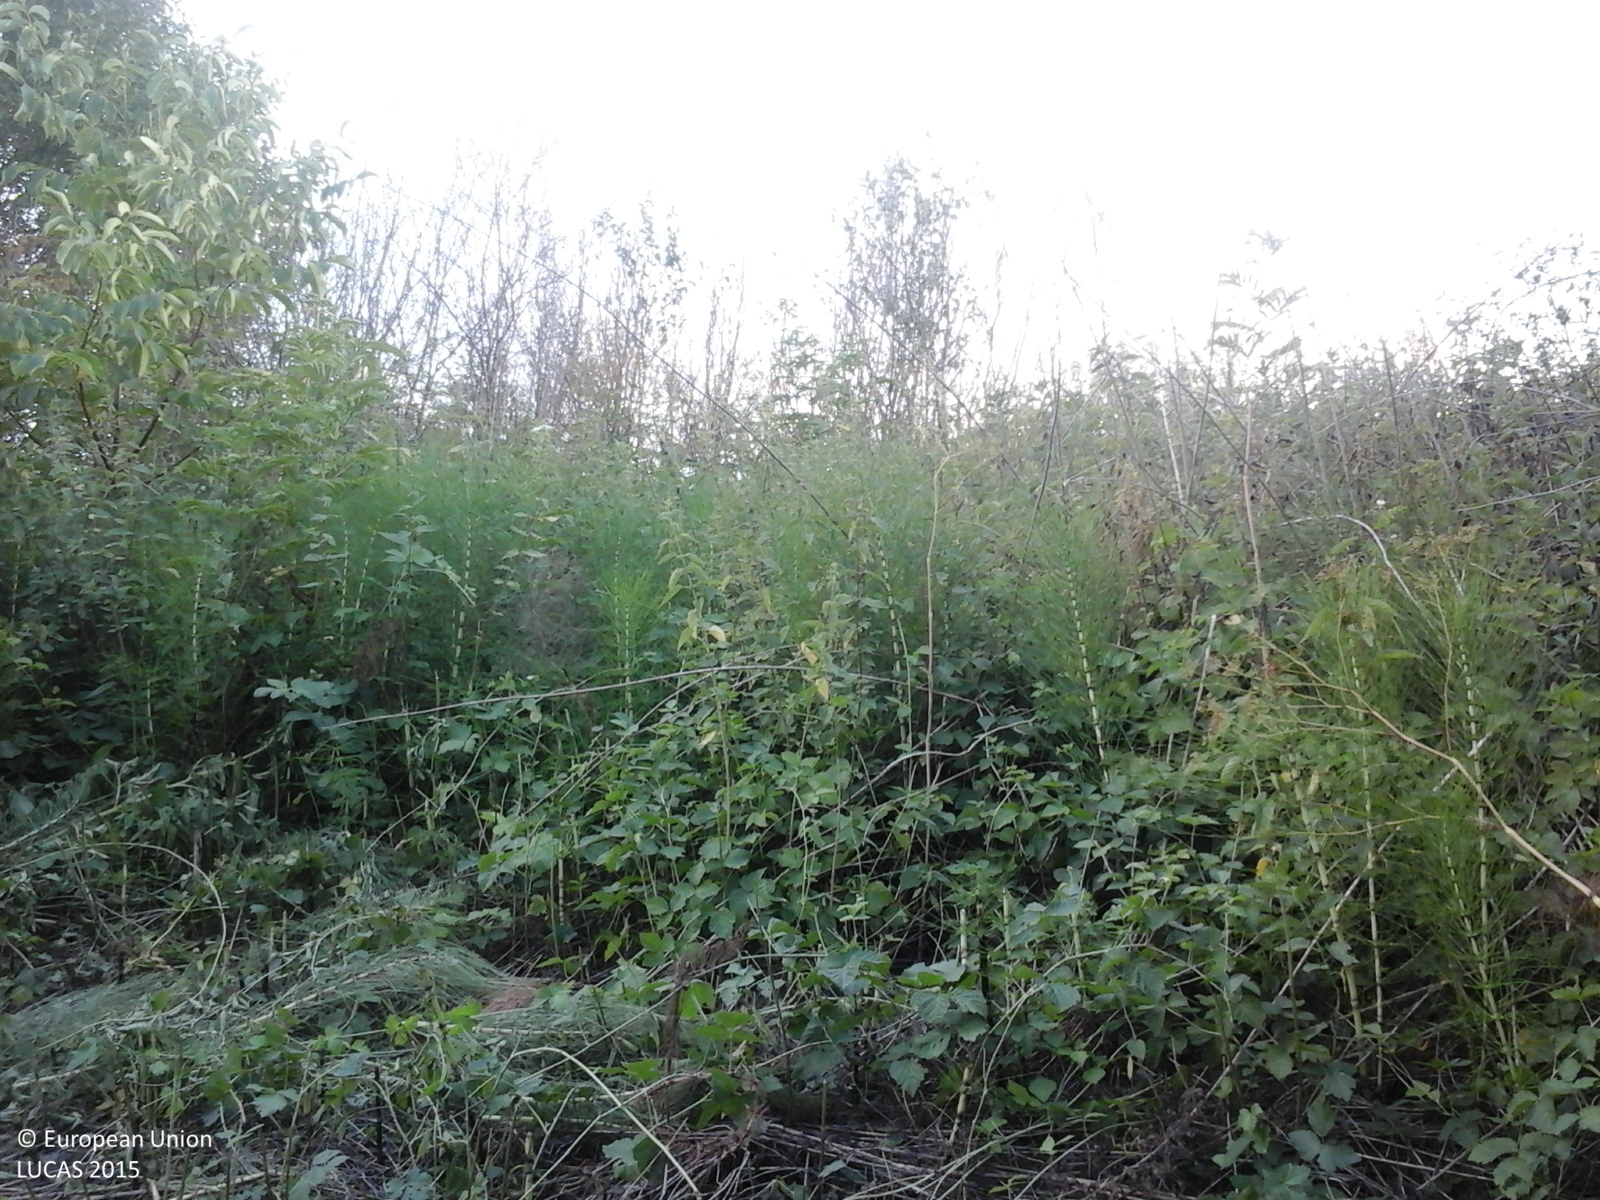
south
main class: Shrubland
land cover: Shrubland with sparse tree cover
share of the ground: > 75 %
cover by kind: shrubs 85 %, herbaceous plants 10 %, broadleaved forest trees 5 %
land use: Fallow land
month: July
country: RO
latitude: 46.2194
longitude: 26.8251
